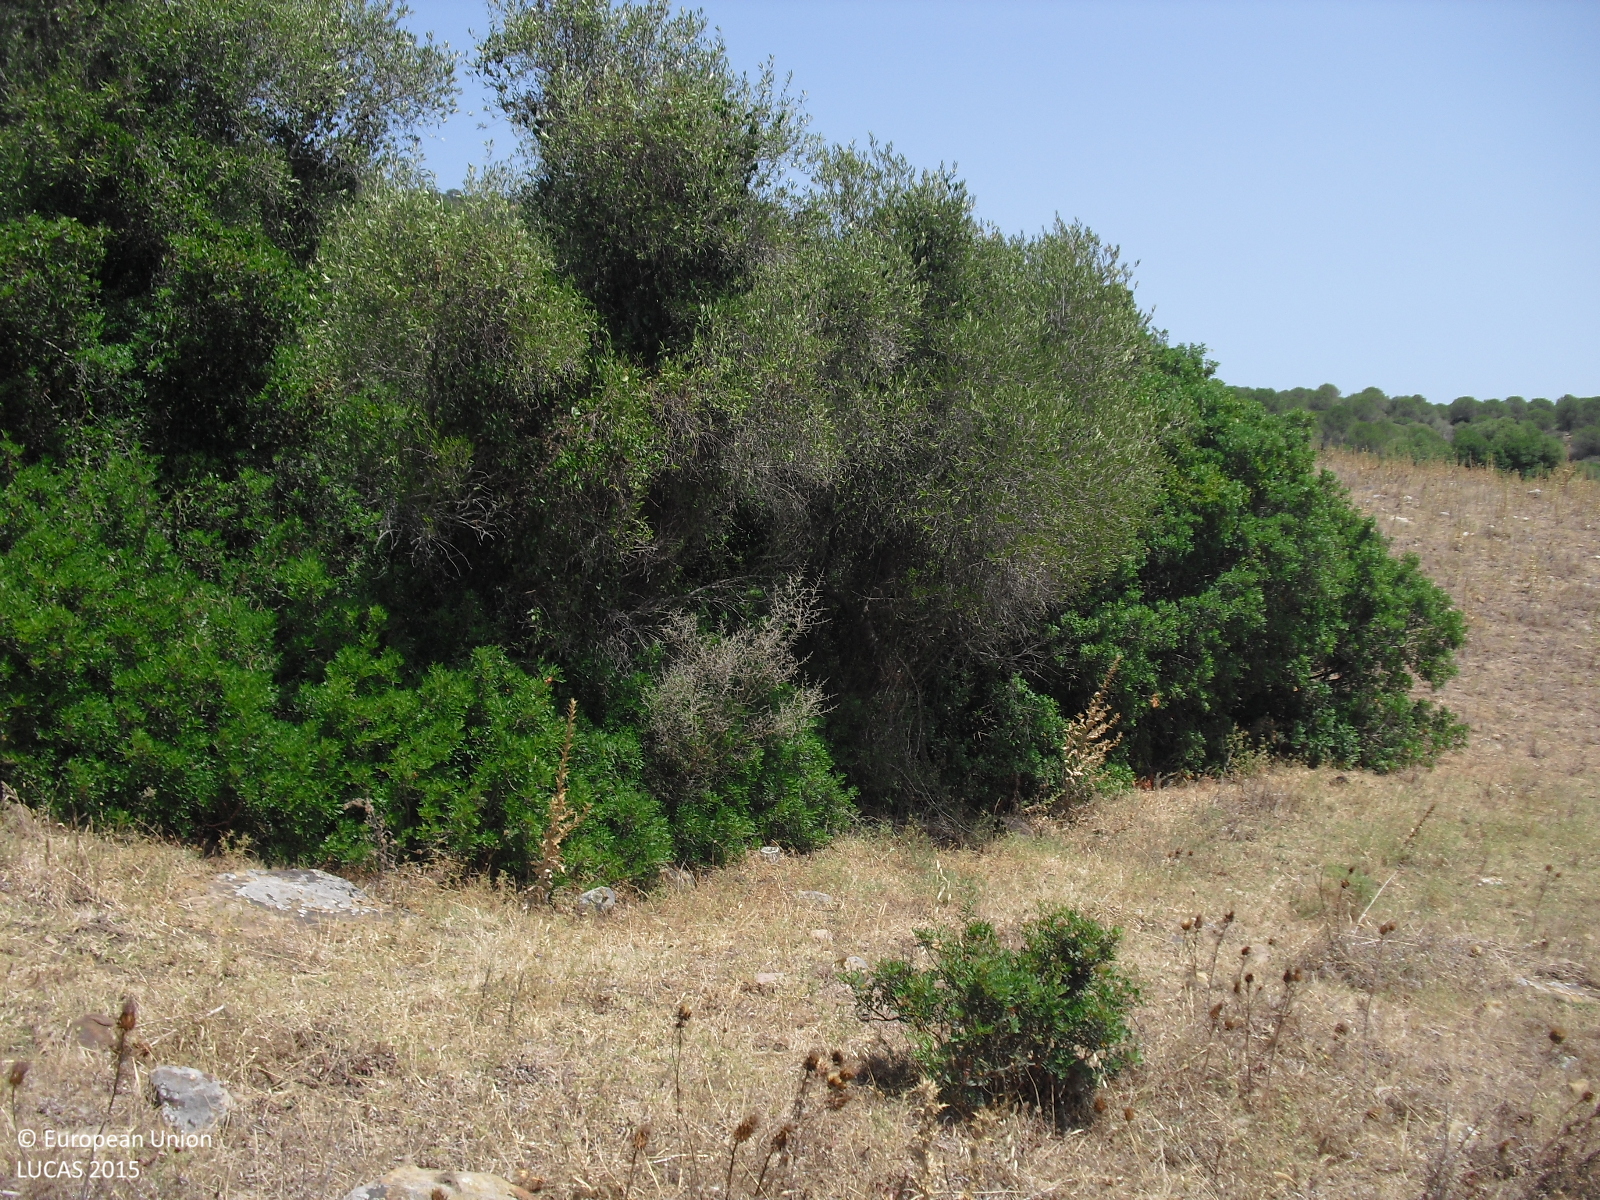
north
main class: Woodland
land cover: Broadleaved woodland
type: broadleaved evergreen forest
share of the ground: 10 - 25 %
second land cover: Shrubland without tree cover
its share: 10 - 25 %
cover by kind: herbaceous plants 70 %, broadleaved forest trees 10 %, shrubs 10 %, unconsolidated bare surface 10 %
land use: Forestry
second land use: Agriculture (excluding fallow land and kitchen gardens)
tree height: < 5 m
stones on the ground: 10 - 25 %
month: July
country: ES
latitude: 36.2687
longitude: -5.5908
